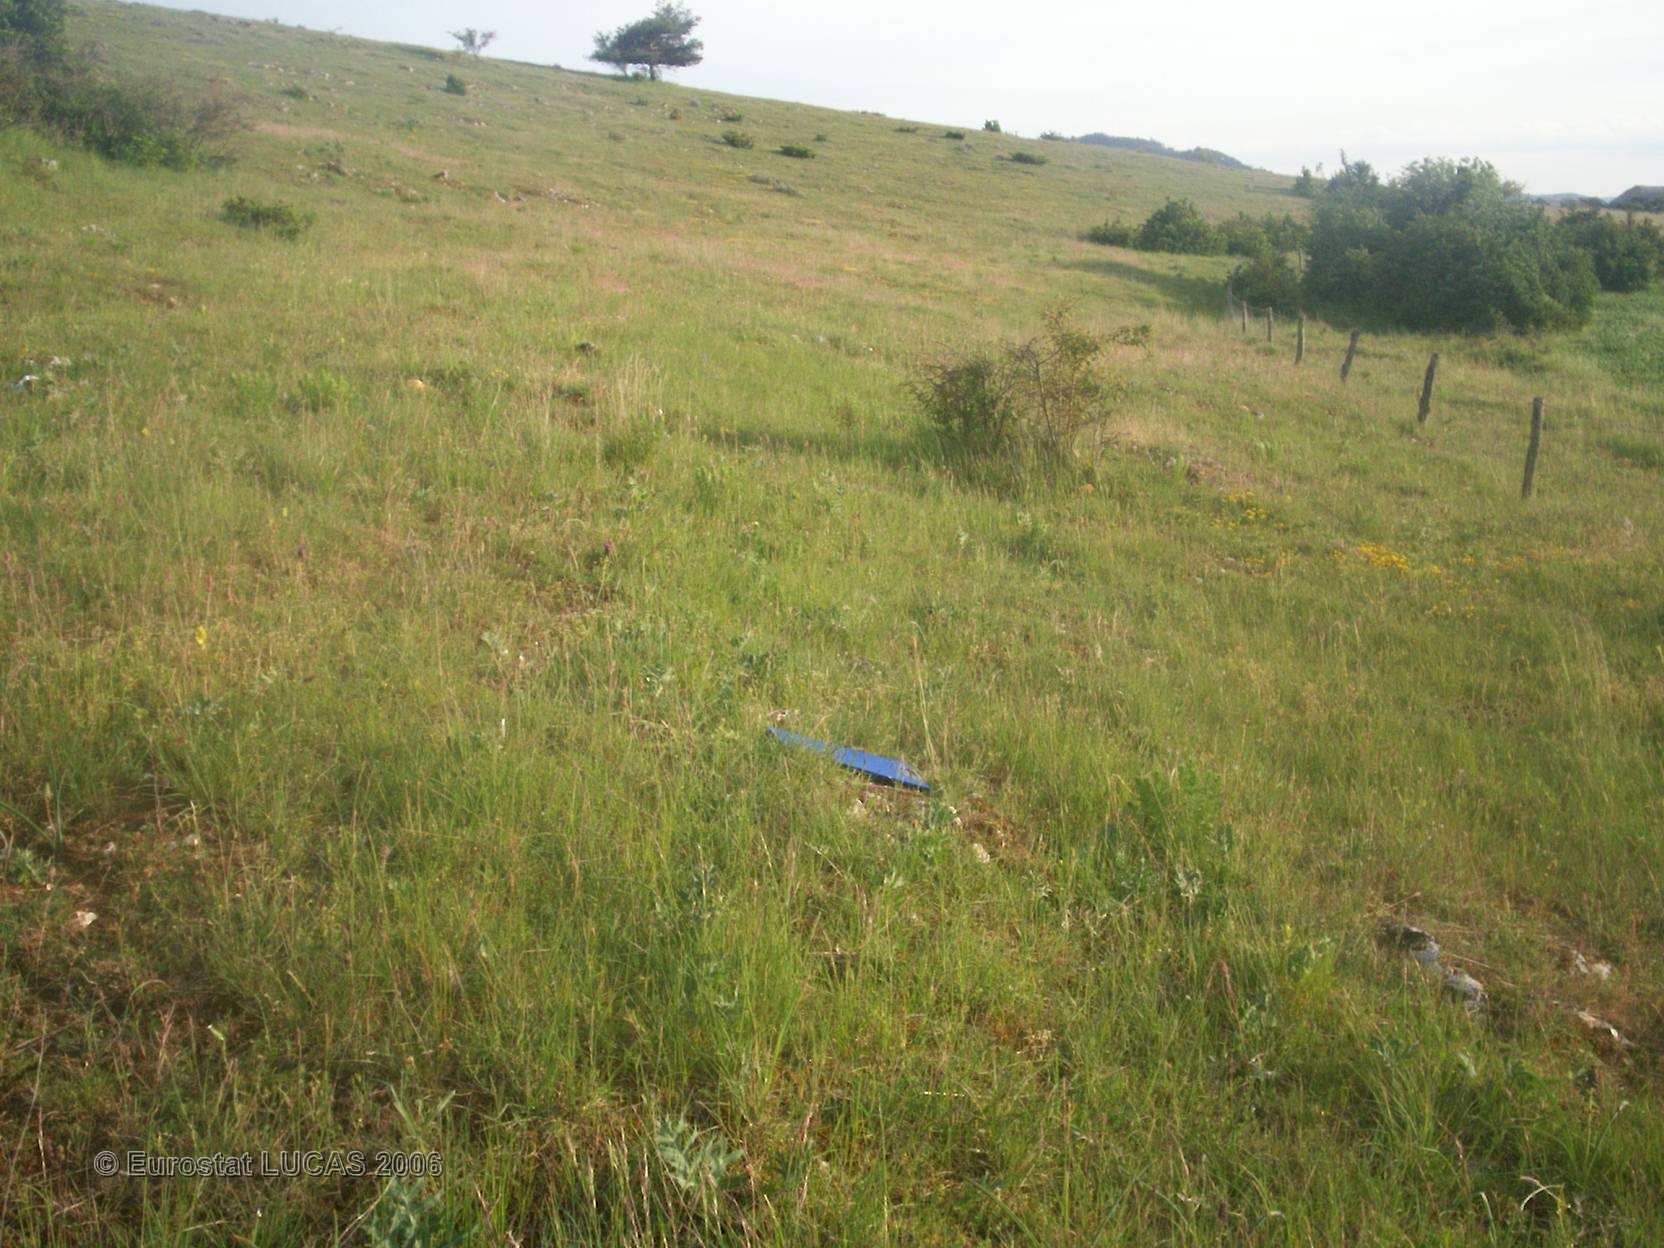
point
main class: Grassland
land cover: Grassland with sparse tree/shrub cover
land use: Agriculture (excluding fallow land and kitchen gardens)
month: June
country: FR
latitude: 44.3782
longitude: 3.4415
